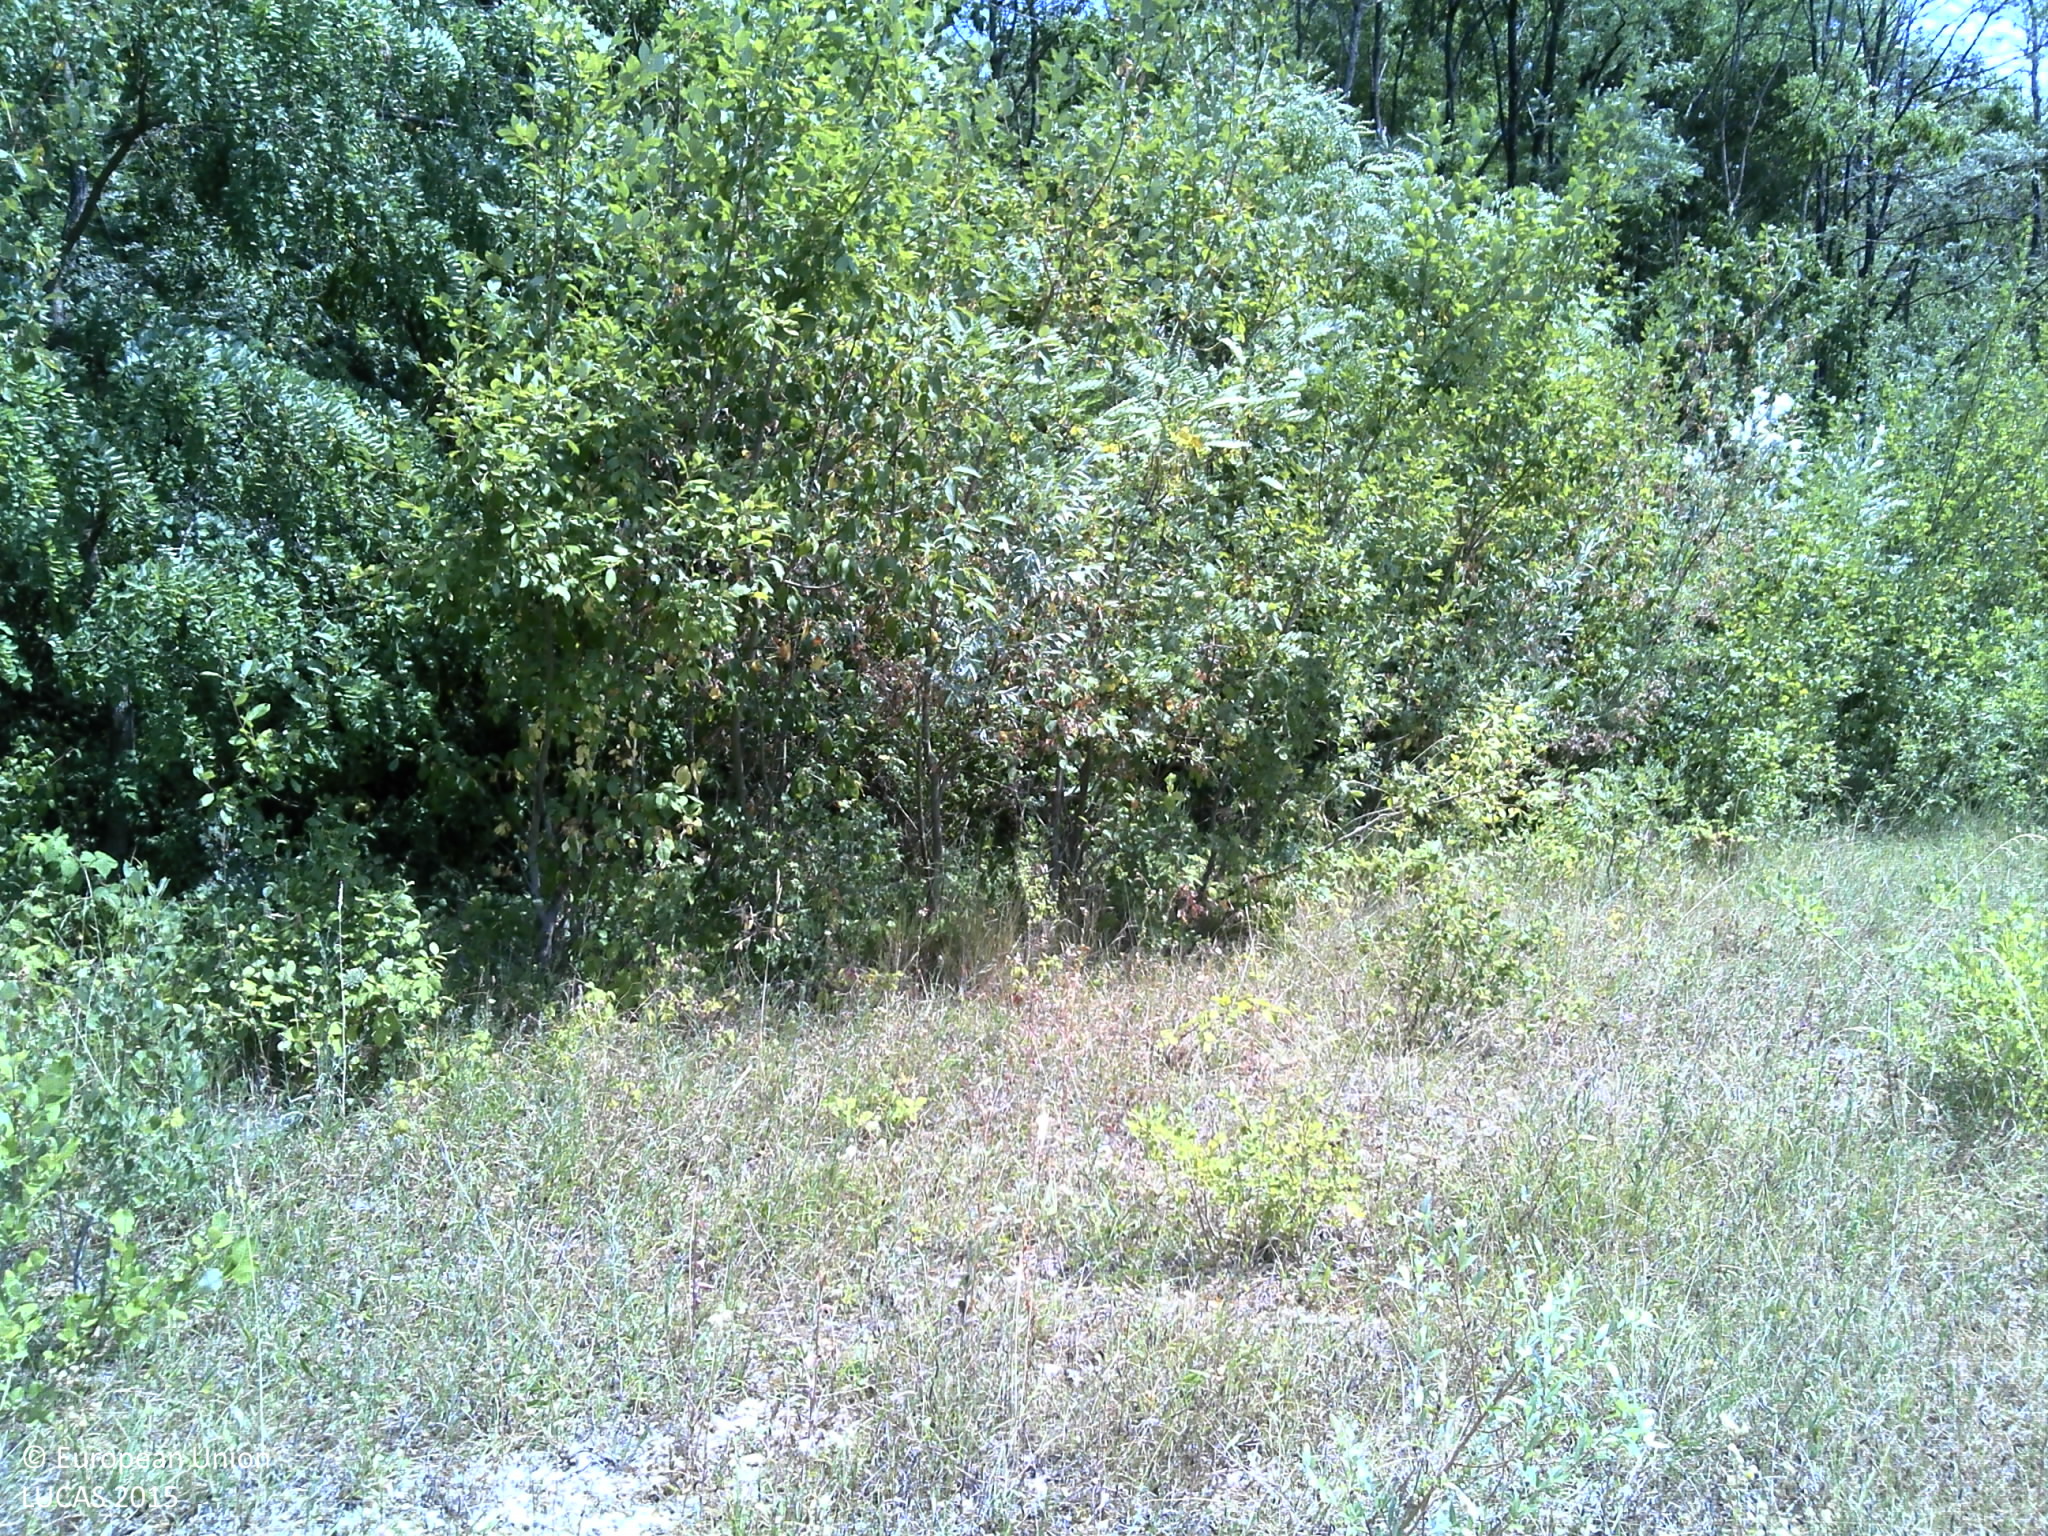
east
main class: Woodland
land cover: Broadleaved woodland
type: beech forest
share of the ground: > 75 %
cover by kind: broadleaved forest trees 85 %, coniferous forest trees 10 %, herbaceous plants 5 %
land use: Forestry
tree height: > 5 m
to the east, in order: Broadleaved woodland; Grassland without tree/shrub cover
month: July
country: FR
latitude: 48.8441
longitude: 4.8879
